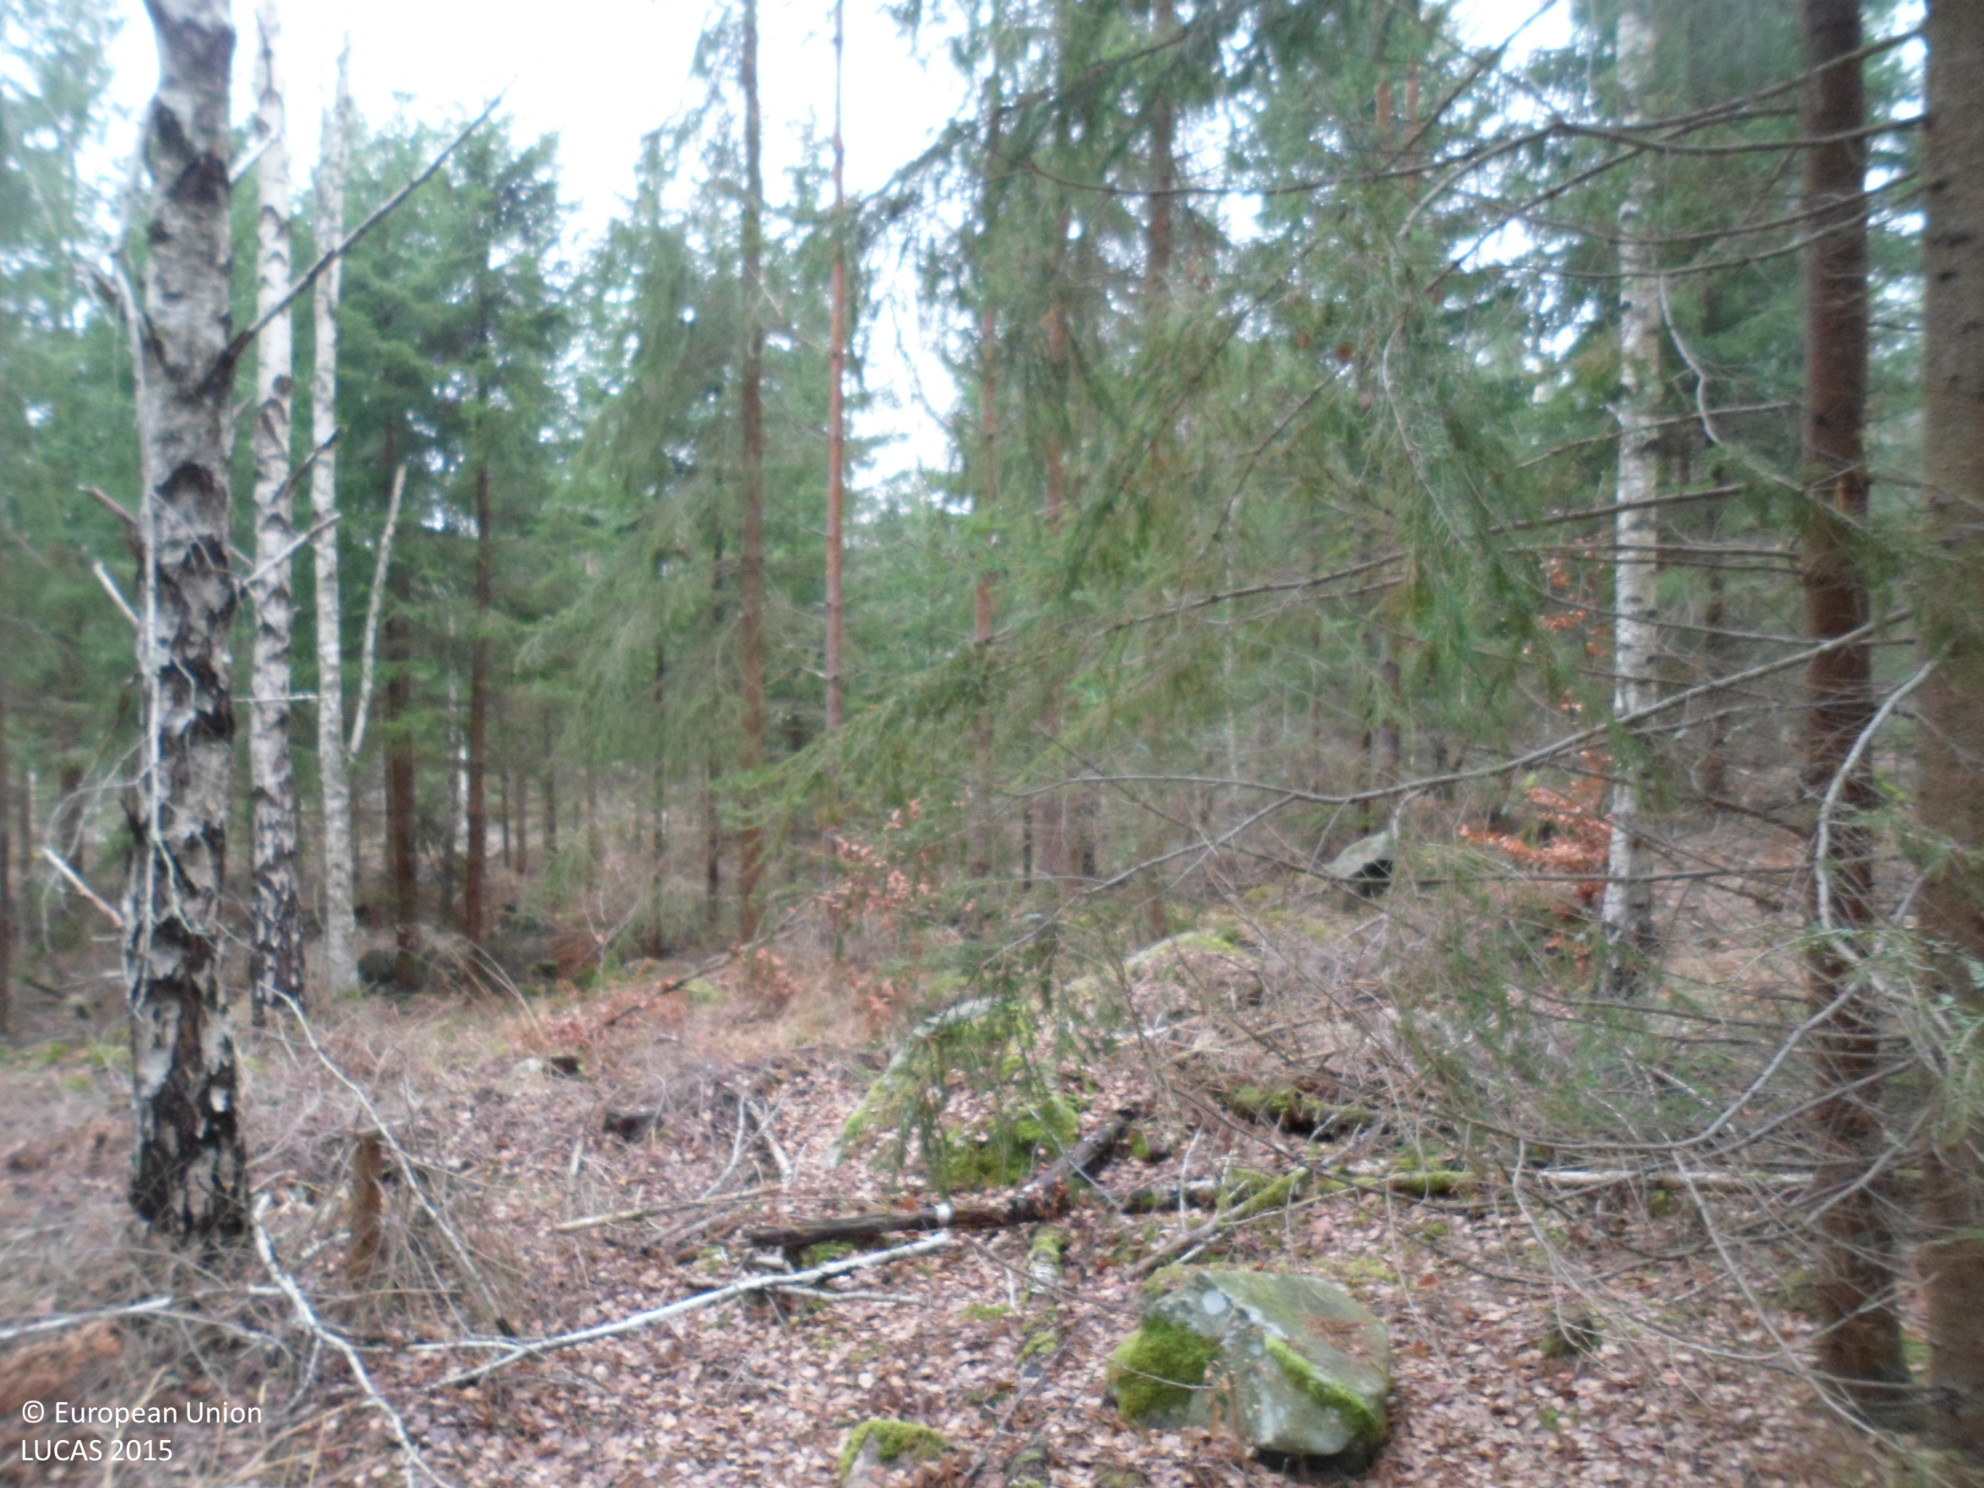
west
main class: Woodland
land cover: Pine dominated coniferous woodland
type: boreal forest
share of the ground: 50 - 75 %
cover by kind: coniferous forest trees 50 %, lichens and mosses 15 %, unconsolidated bare surface 15 %, broadleaved forest trees 10 %, shrubs 10 %
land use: Forestry
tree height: > 5 m
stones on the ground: > 50 %
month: November
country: SE
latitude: 57.0489
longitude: 16.1811
